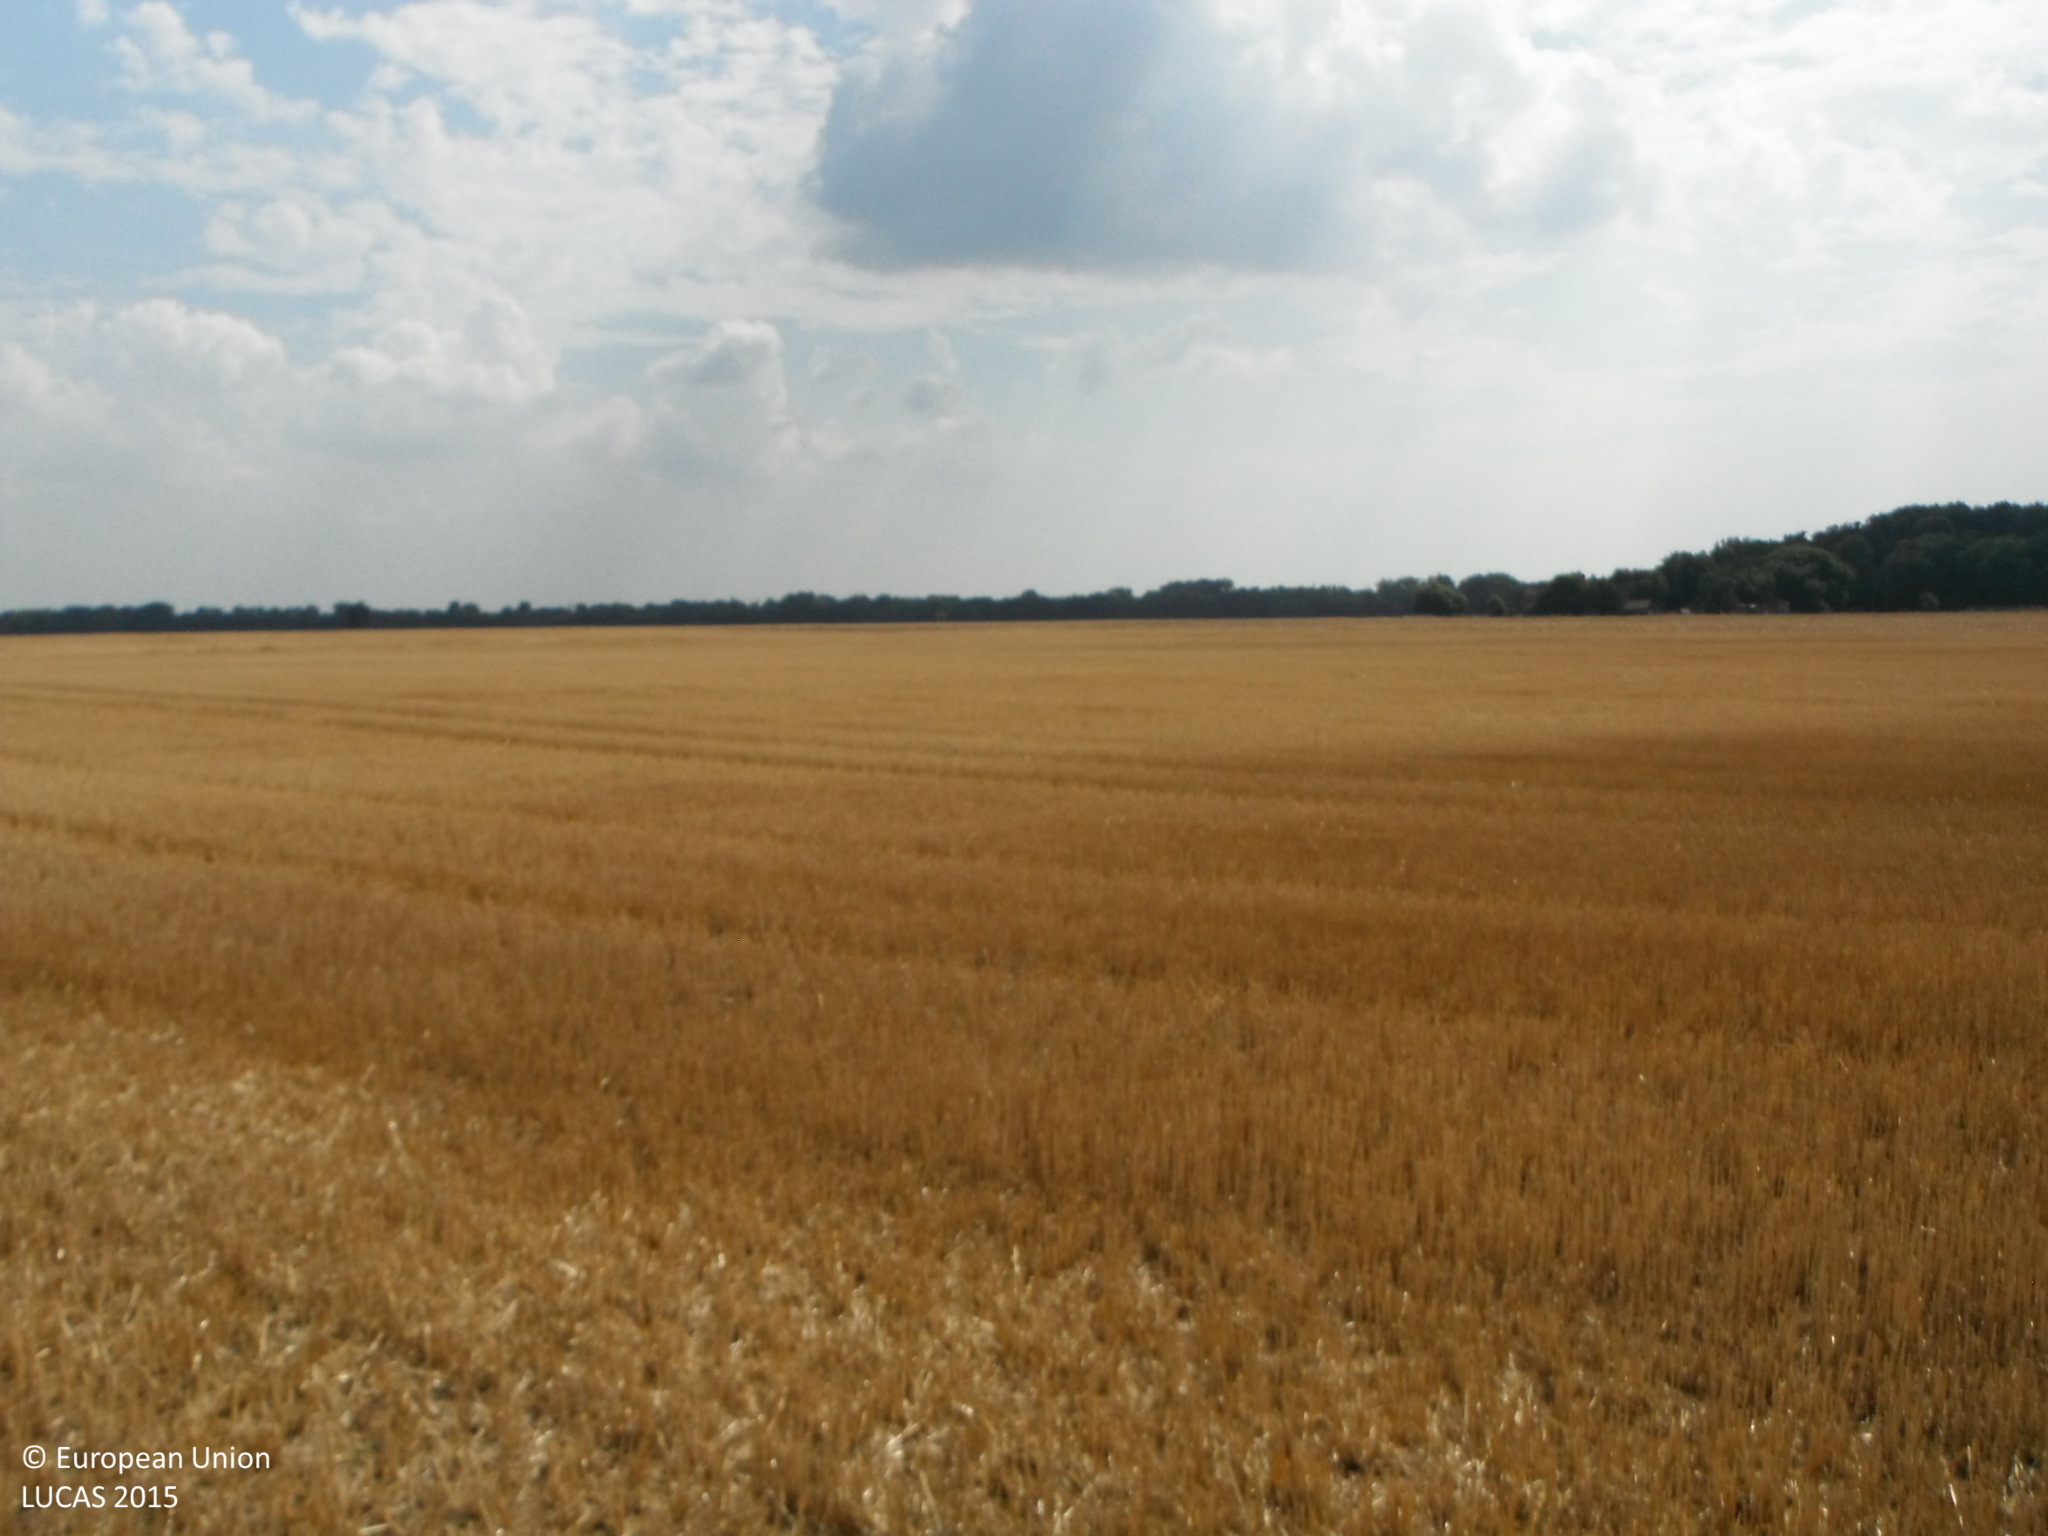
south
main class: Cropland
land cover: Common wheat
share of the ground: > 75 %
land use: Agriculture (excluding fallow land and kitchen gardens)
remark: Harvested field
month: August
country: SK
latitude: 48.1291
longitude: 17.5207
